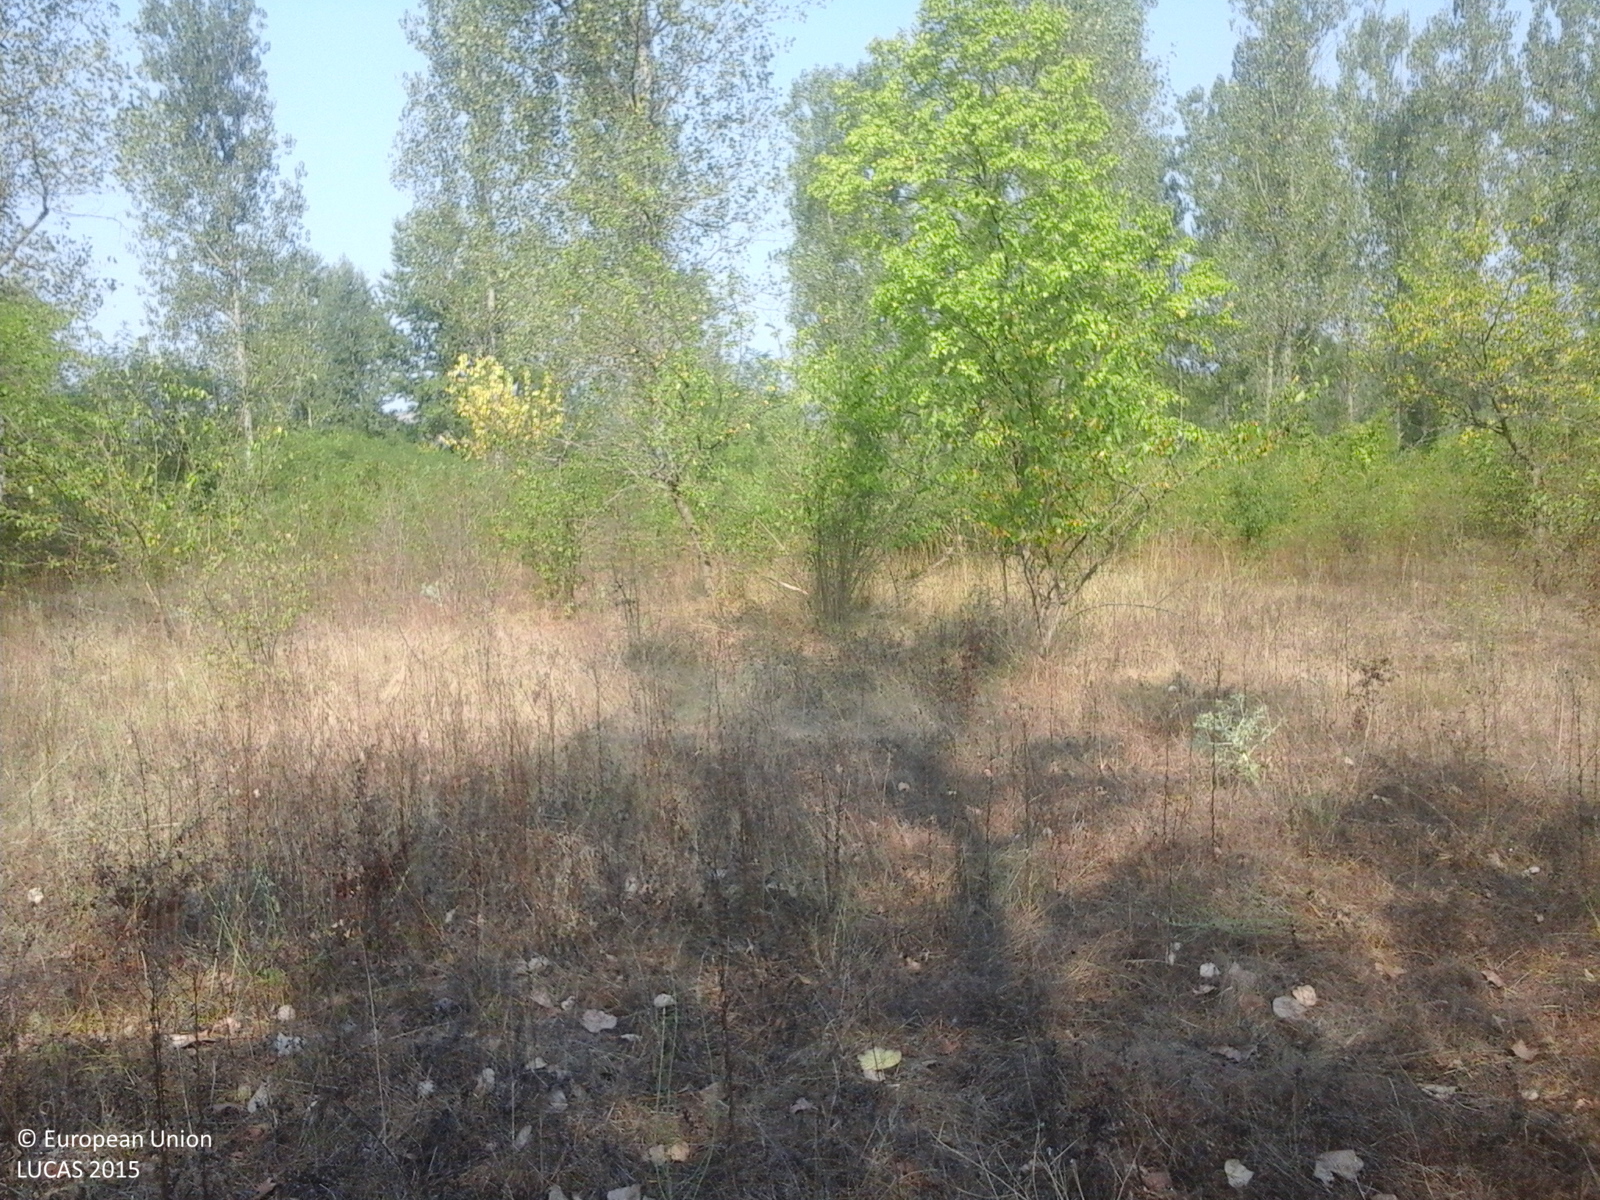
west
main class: Grassland
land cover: Grassland with sparse tree/shrub cover
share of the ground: > 75 %
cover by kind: herbaceous plants 85 %, shrubs 10 %, broadleaved forest trees 5 %
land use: Fallow land
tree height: < 5 m
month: August
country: RO
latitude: 44.7946
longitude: 23.5184
